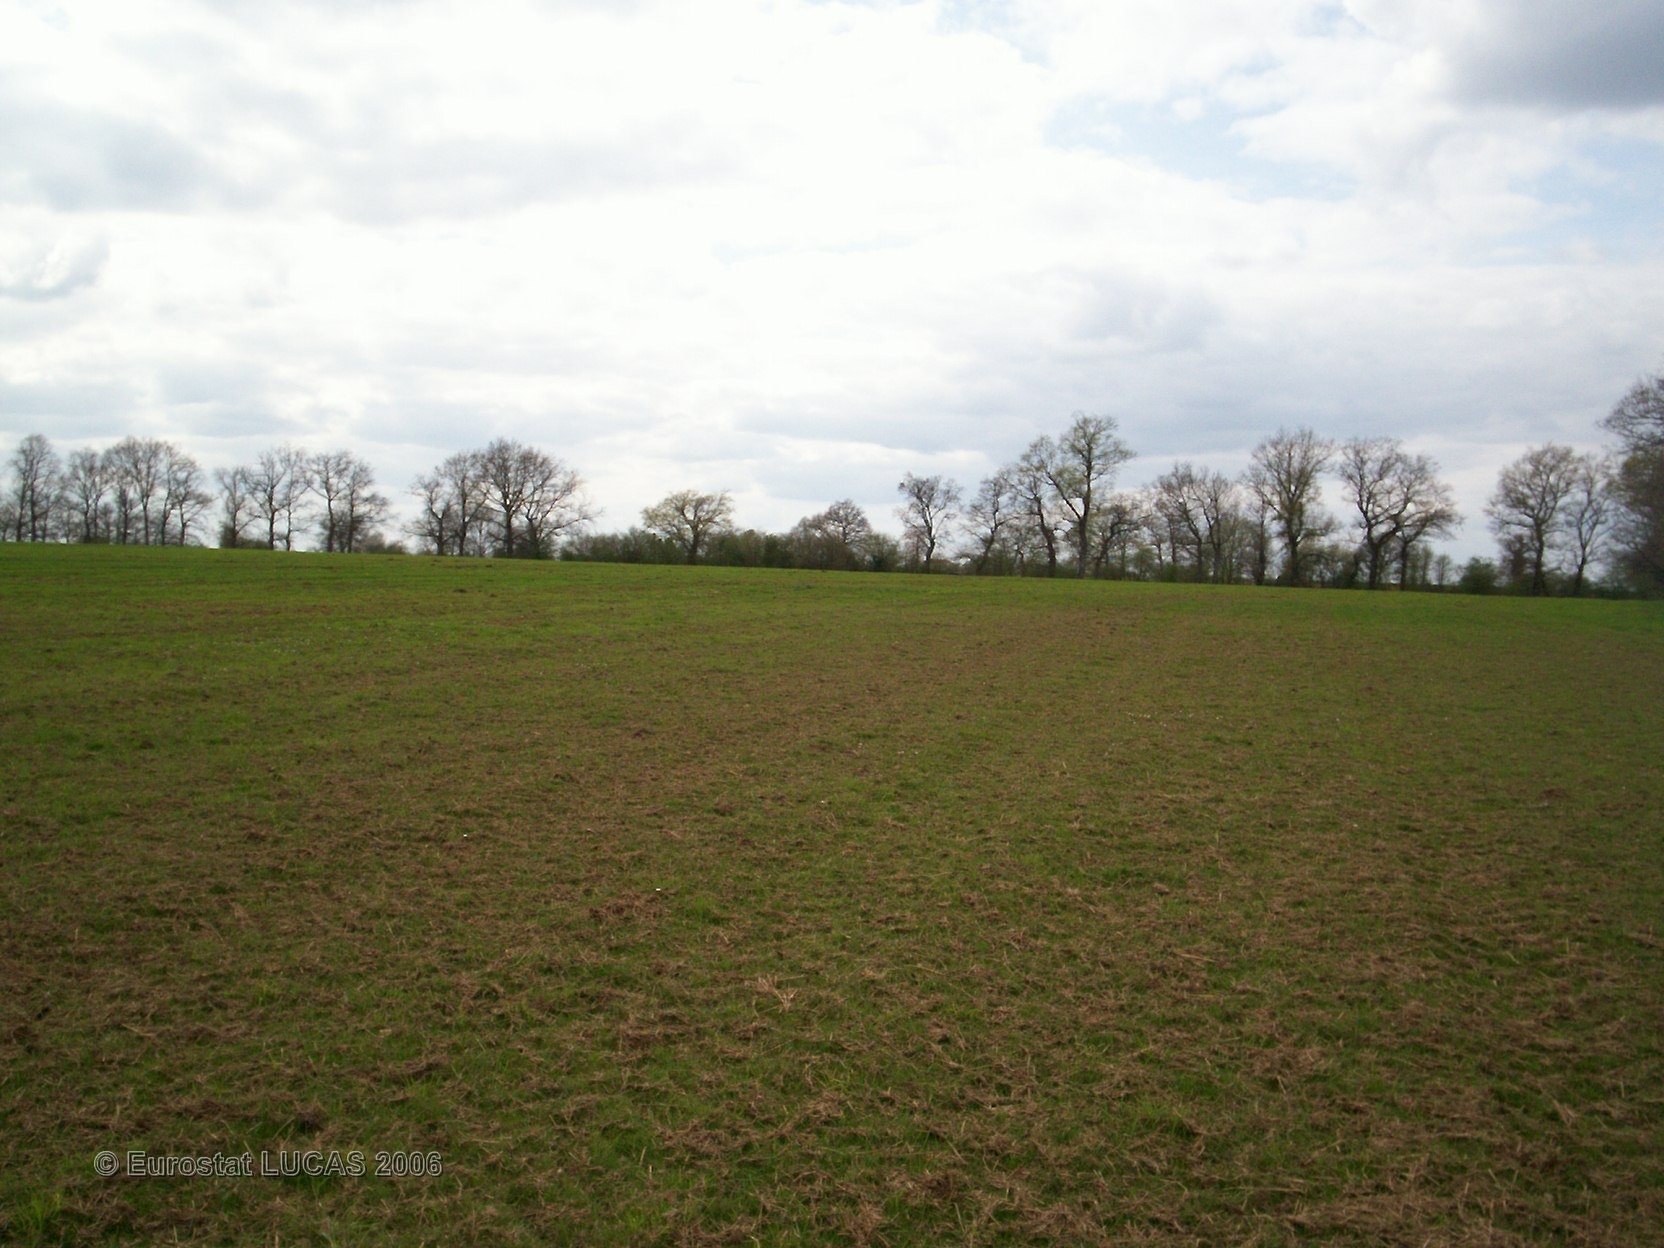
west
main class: Grassland
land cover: Grassland without tree/shrub cover
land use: Agriculture (excluding fallow land and kitchen gardens)
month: April
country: FR
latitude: 46.1135
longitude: 0.5522
